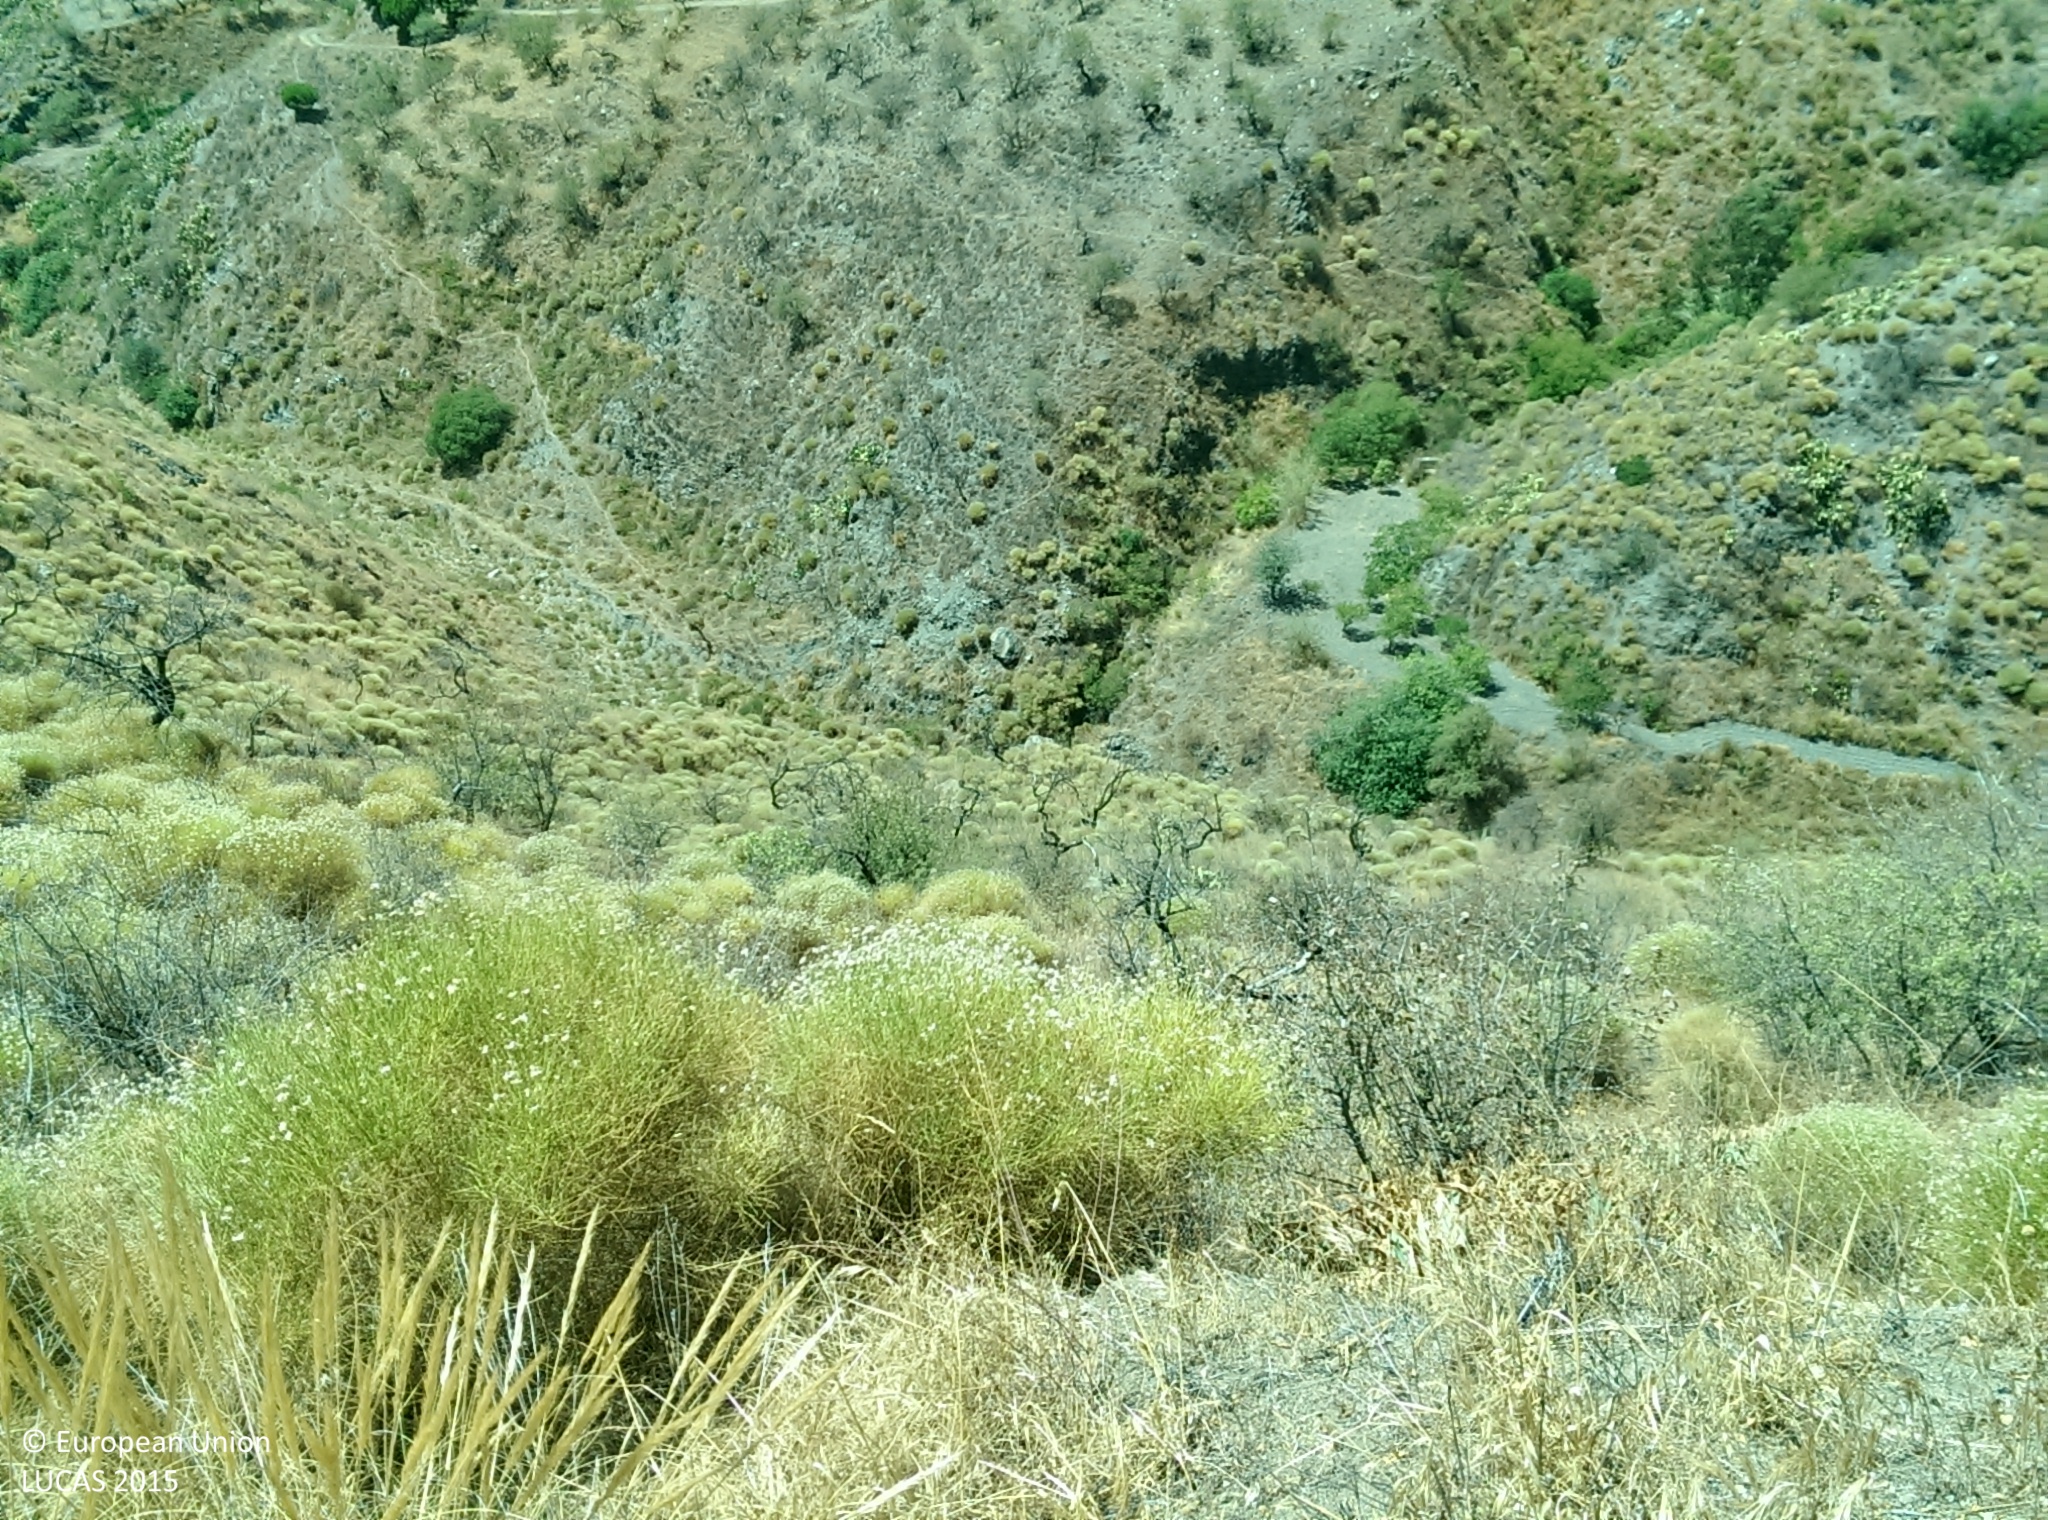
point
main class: Shrubland
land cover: Shrubland with sparse tree cover
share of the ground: > 75 %
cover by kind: shrubs 75 %, herbaceous plants 20 %, broadleaved forest trees 5 %
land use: Abandoned areas
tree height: < 5 m
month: August
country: ES
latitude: 36.8233
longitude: -3.1980
